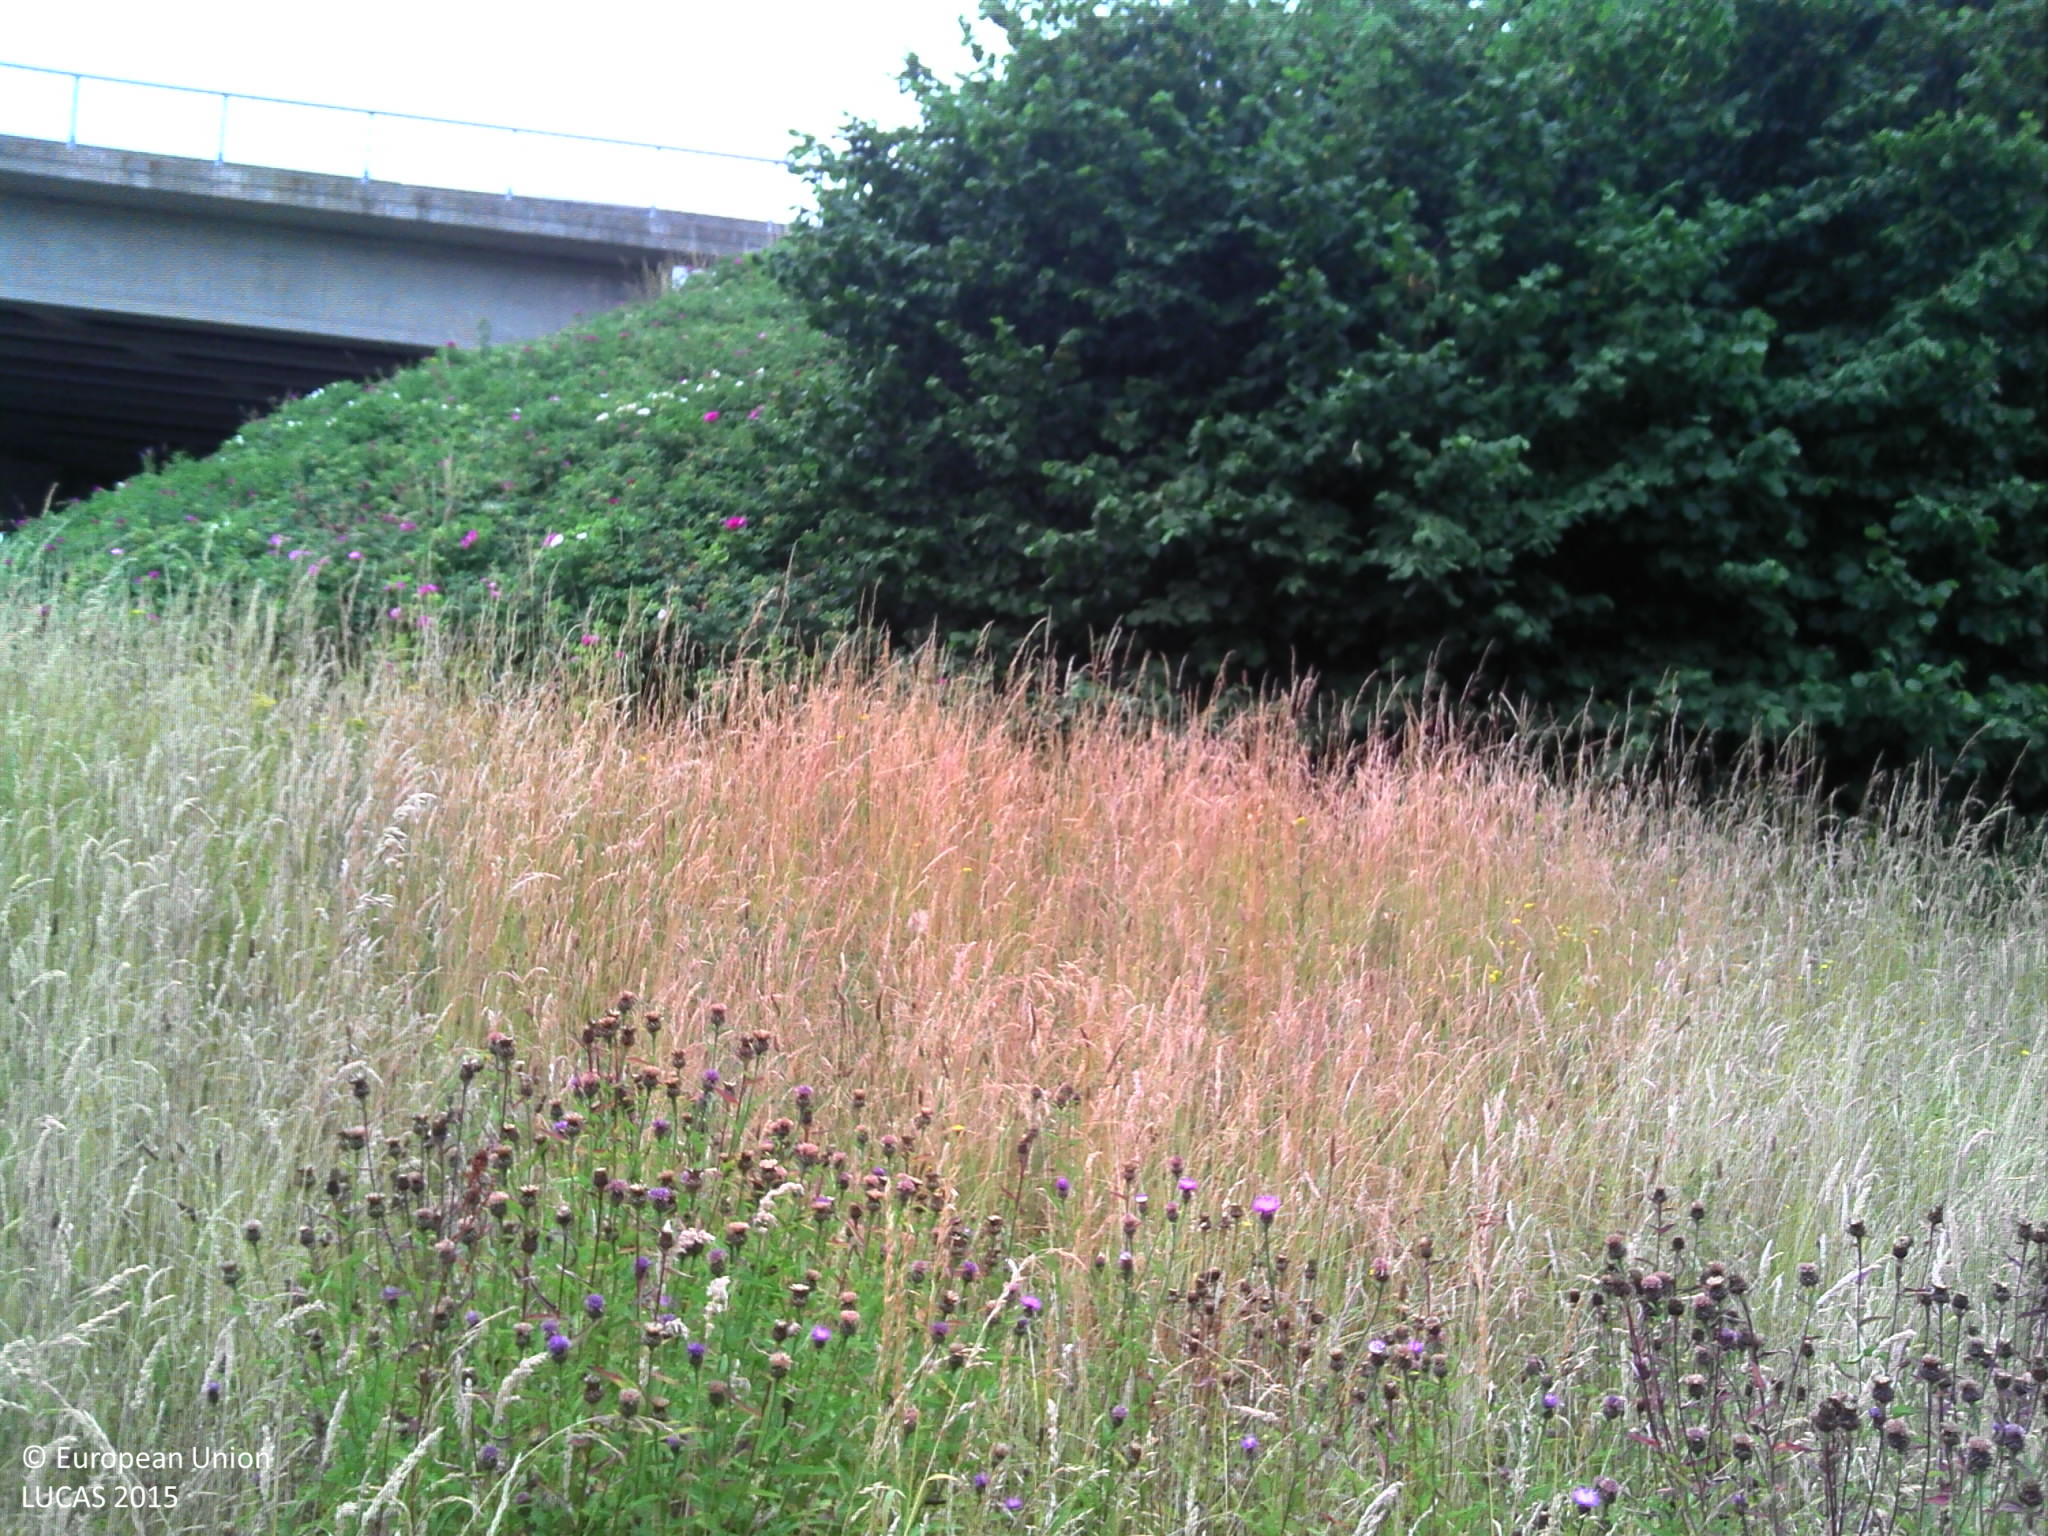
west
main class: Grassland
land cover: Spontaneously vegetated surfaces
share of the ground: > 75 %
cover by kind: herbaceous plants 100 %
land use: Semi-natural and natural areas not in use
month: July
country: BE
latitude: 51.2094
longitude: 3.5365
